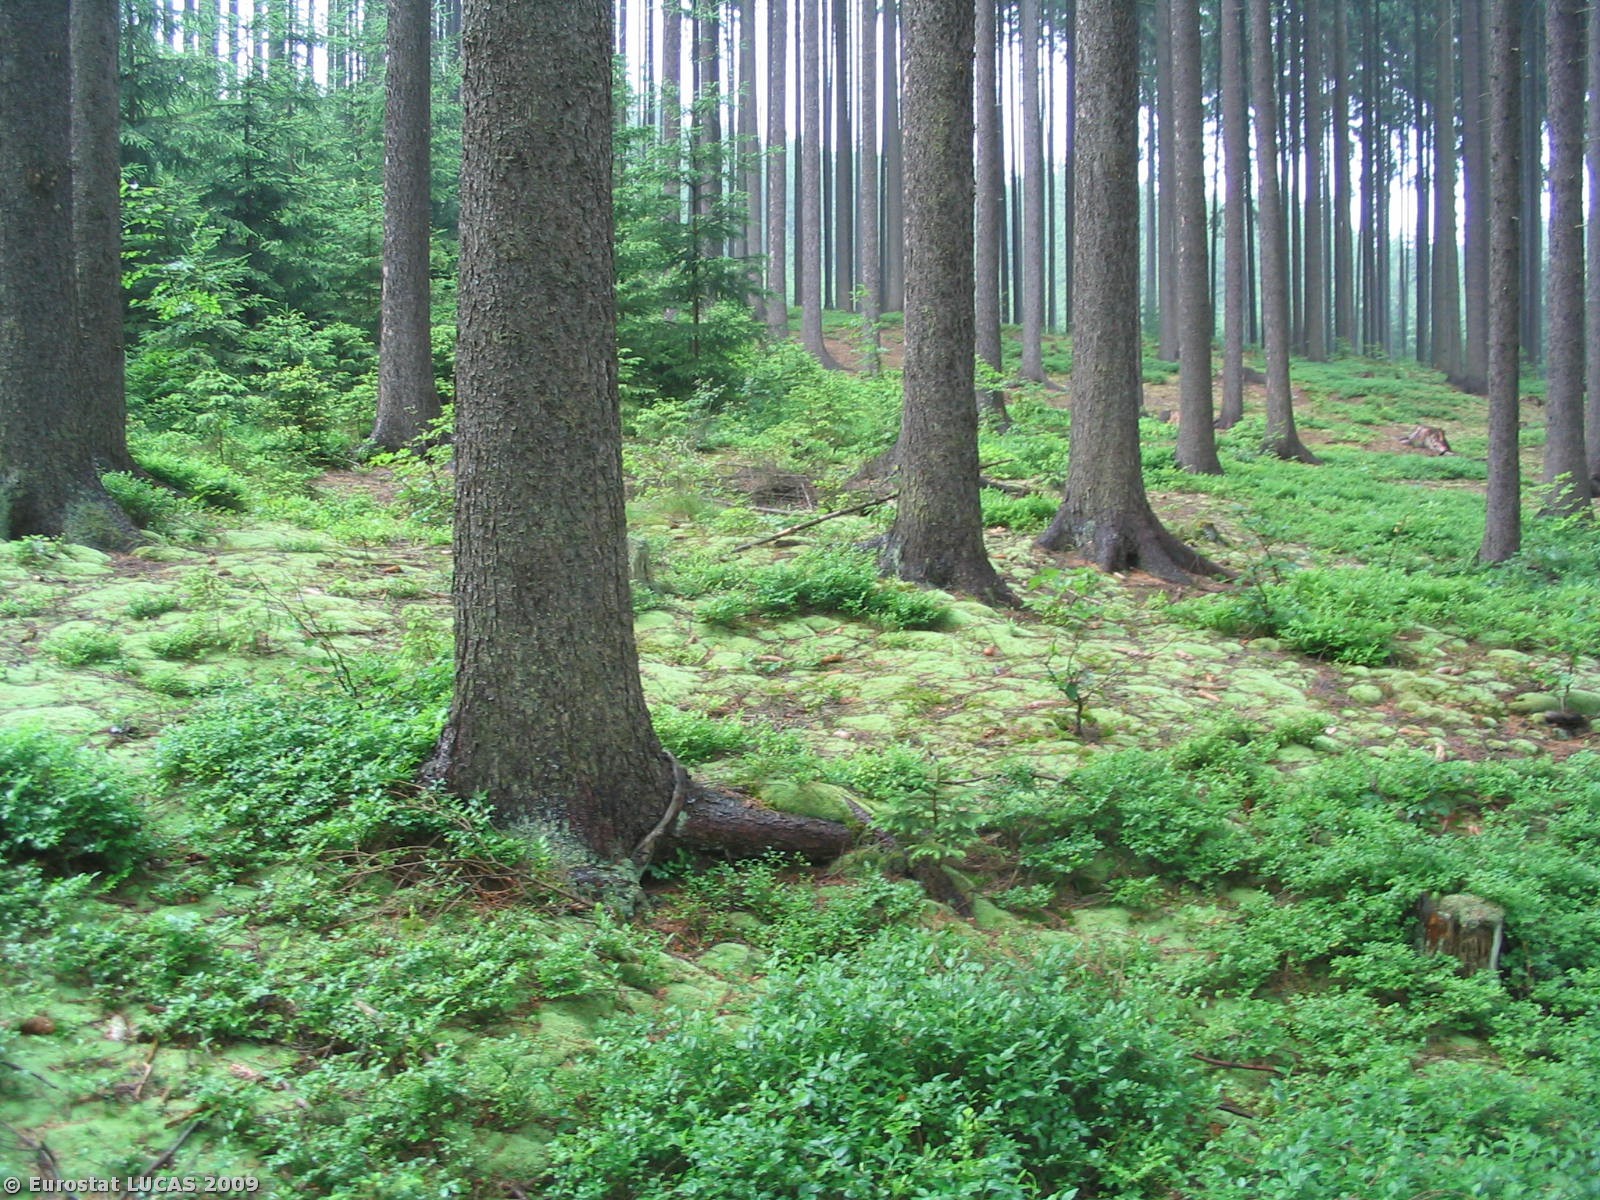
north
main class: Woodland
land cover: Coniferous woodland
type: hemiboreal forest and nemoral coniferous forest and mixed broadleaved-coniferous forest
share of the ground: > 75 %
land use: Forestry
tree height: > 5 m
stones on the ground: < 10 %
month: June
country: CZ
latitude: 49.5049
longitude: 18.7339
